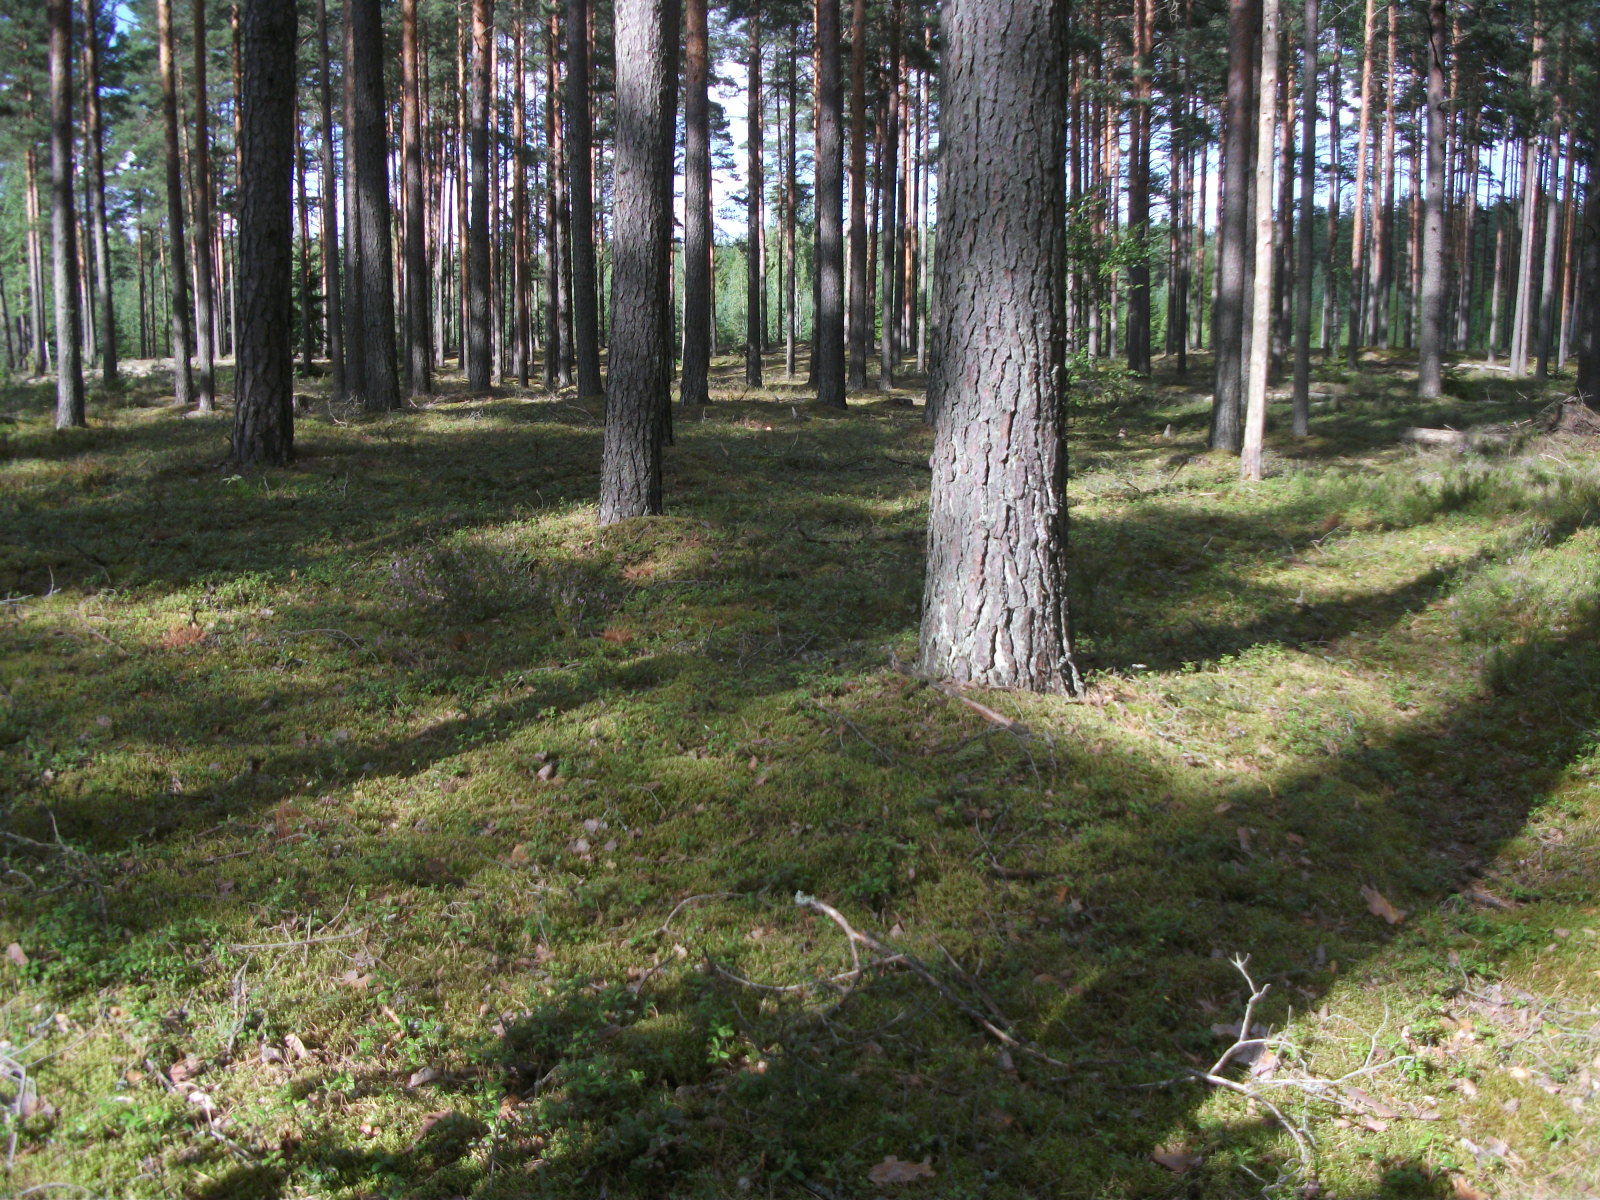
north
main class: Woodland
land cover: Pine dominated coniferous woodland
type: hemiboreal forest and nemoral coniferous forest and mixed broadleaved-coniferous forest
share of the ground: > 75 %
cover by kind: coniferous forest trees 80 %, lichens and mosses 20 %
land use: Forestry
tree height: > 5 m
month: August
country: LV
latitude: 56.4658
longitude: 26.3918
